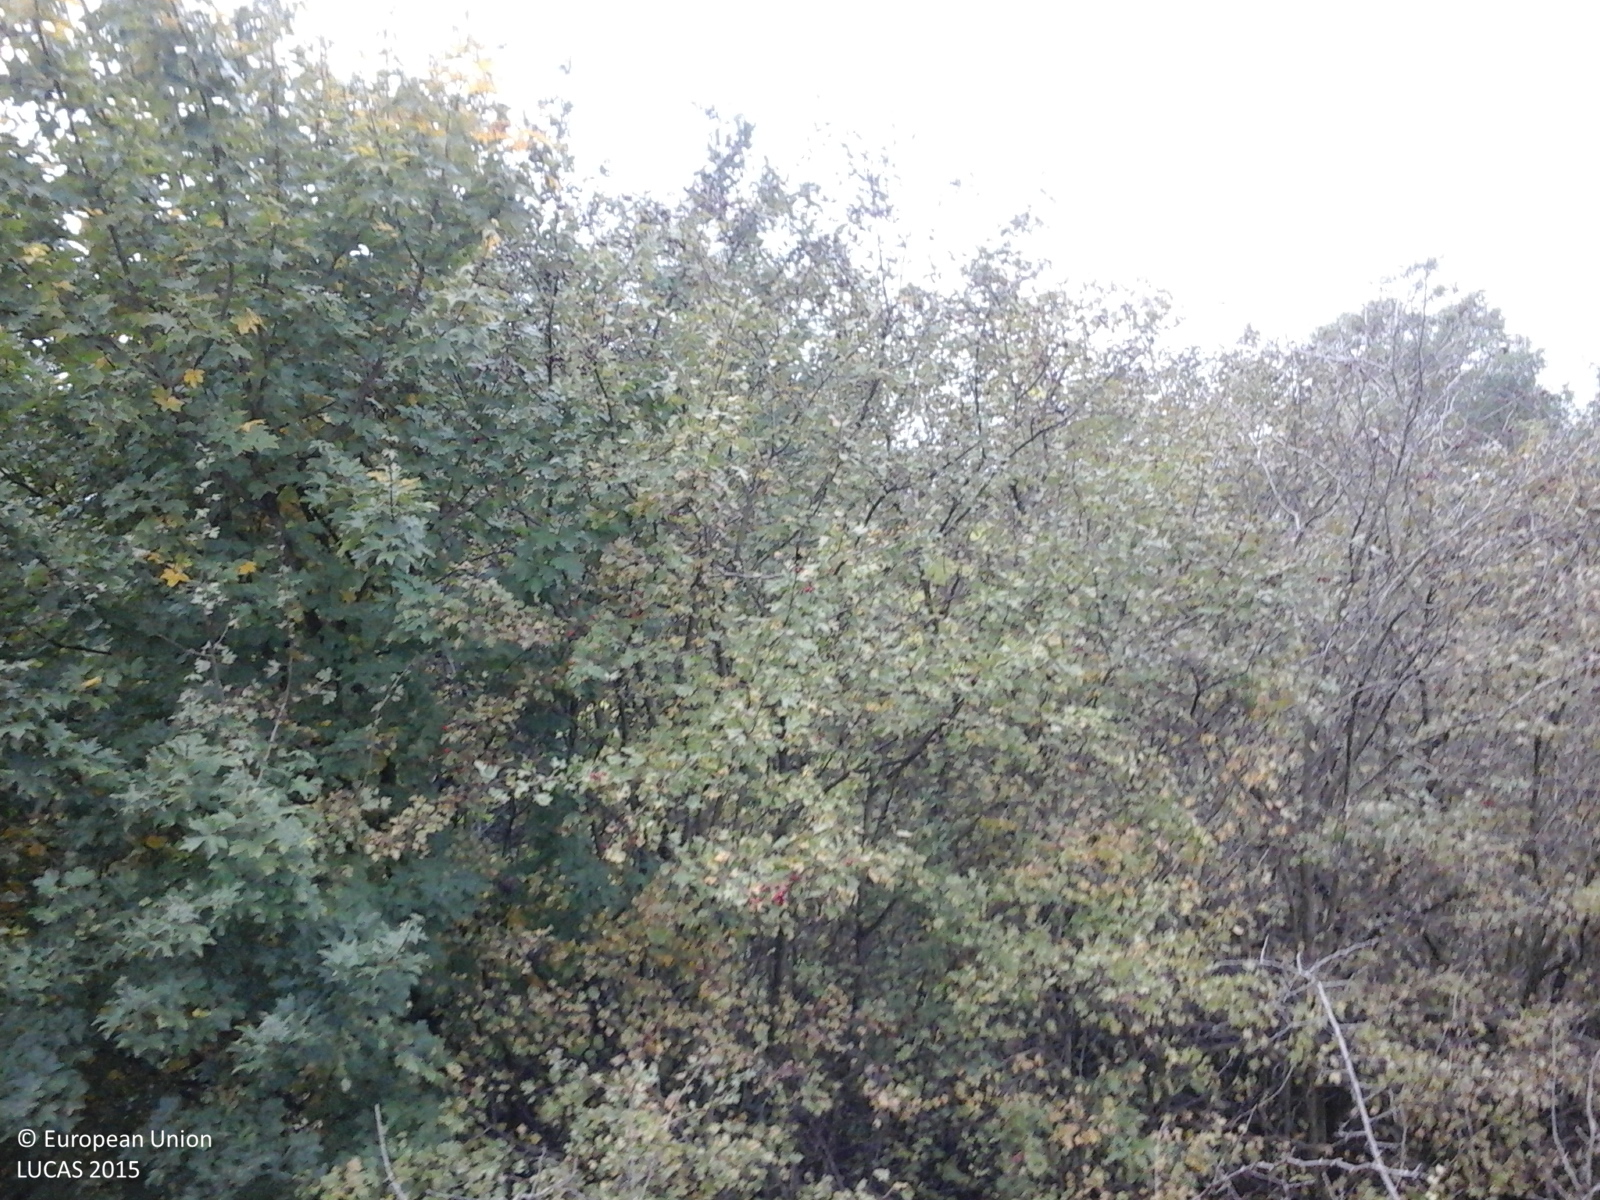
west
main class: Grassland
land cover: Grassland with sparse tree/shrub cover
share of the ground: > 75 %
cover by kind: herbaceous plants 95 %, broadleaved forest trees 5 %
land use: Agriculture (excluding fallow land and kitchen gardens)
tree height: < 5 m
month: October
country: RO
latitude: 45.7587
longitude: 24.1003
